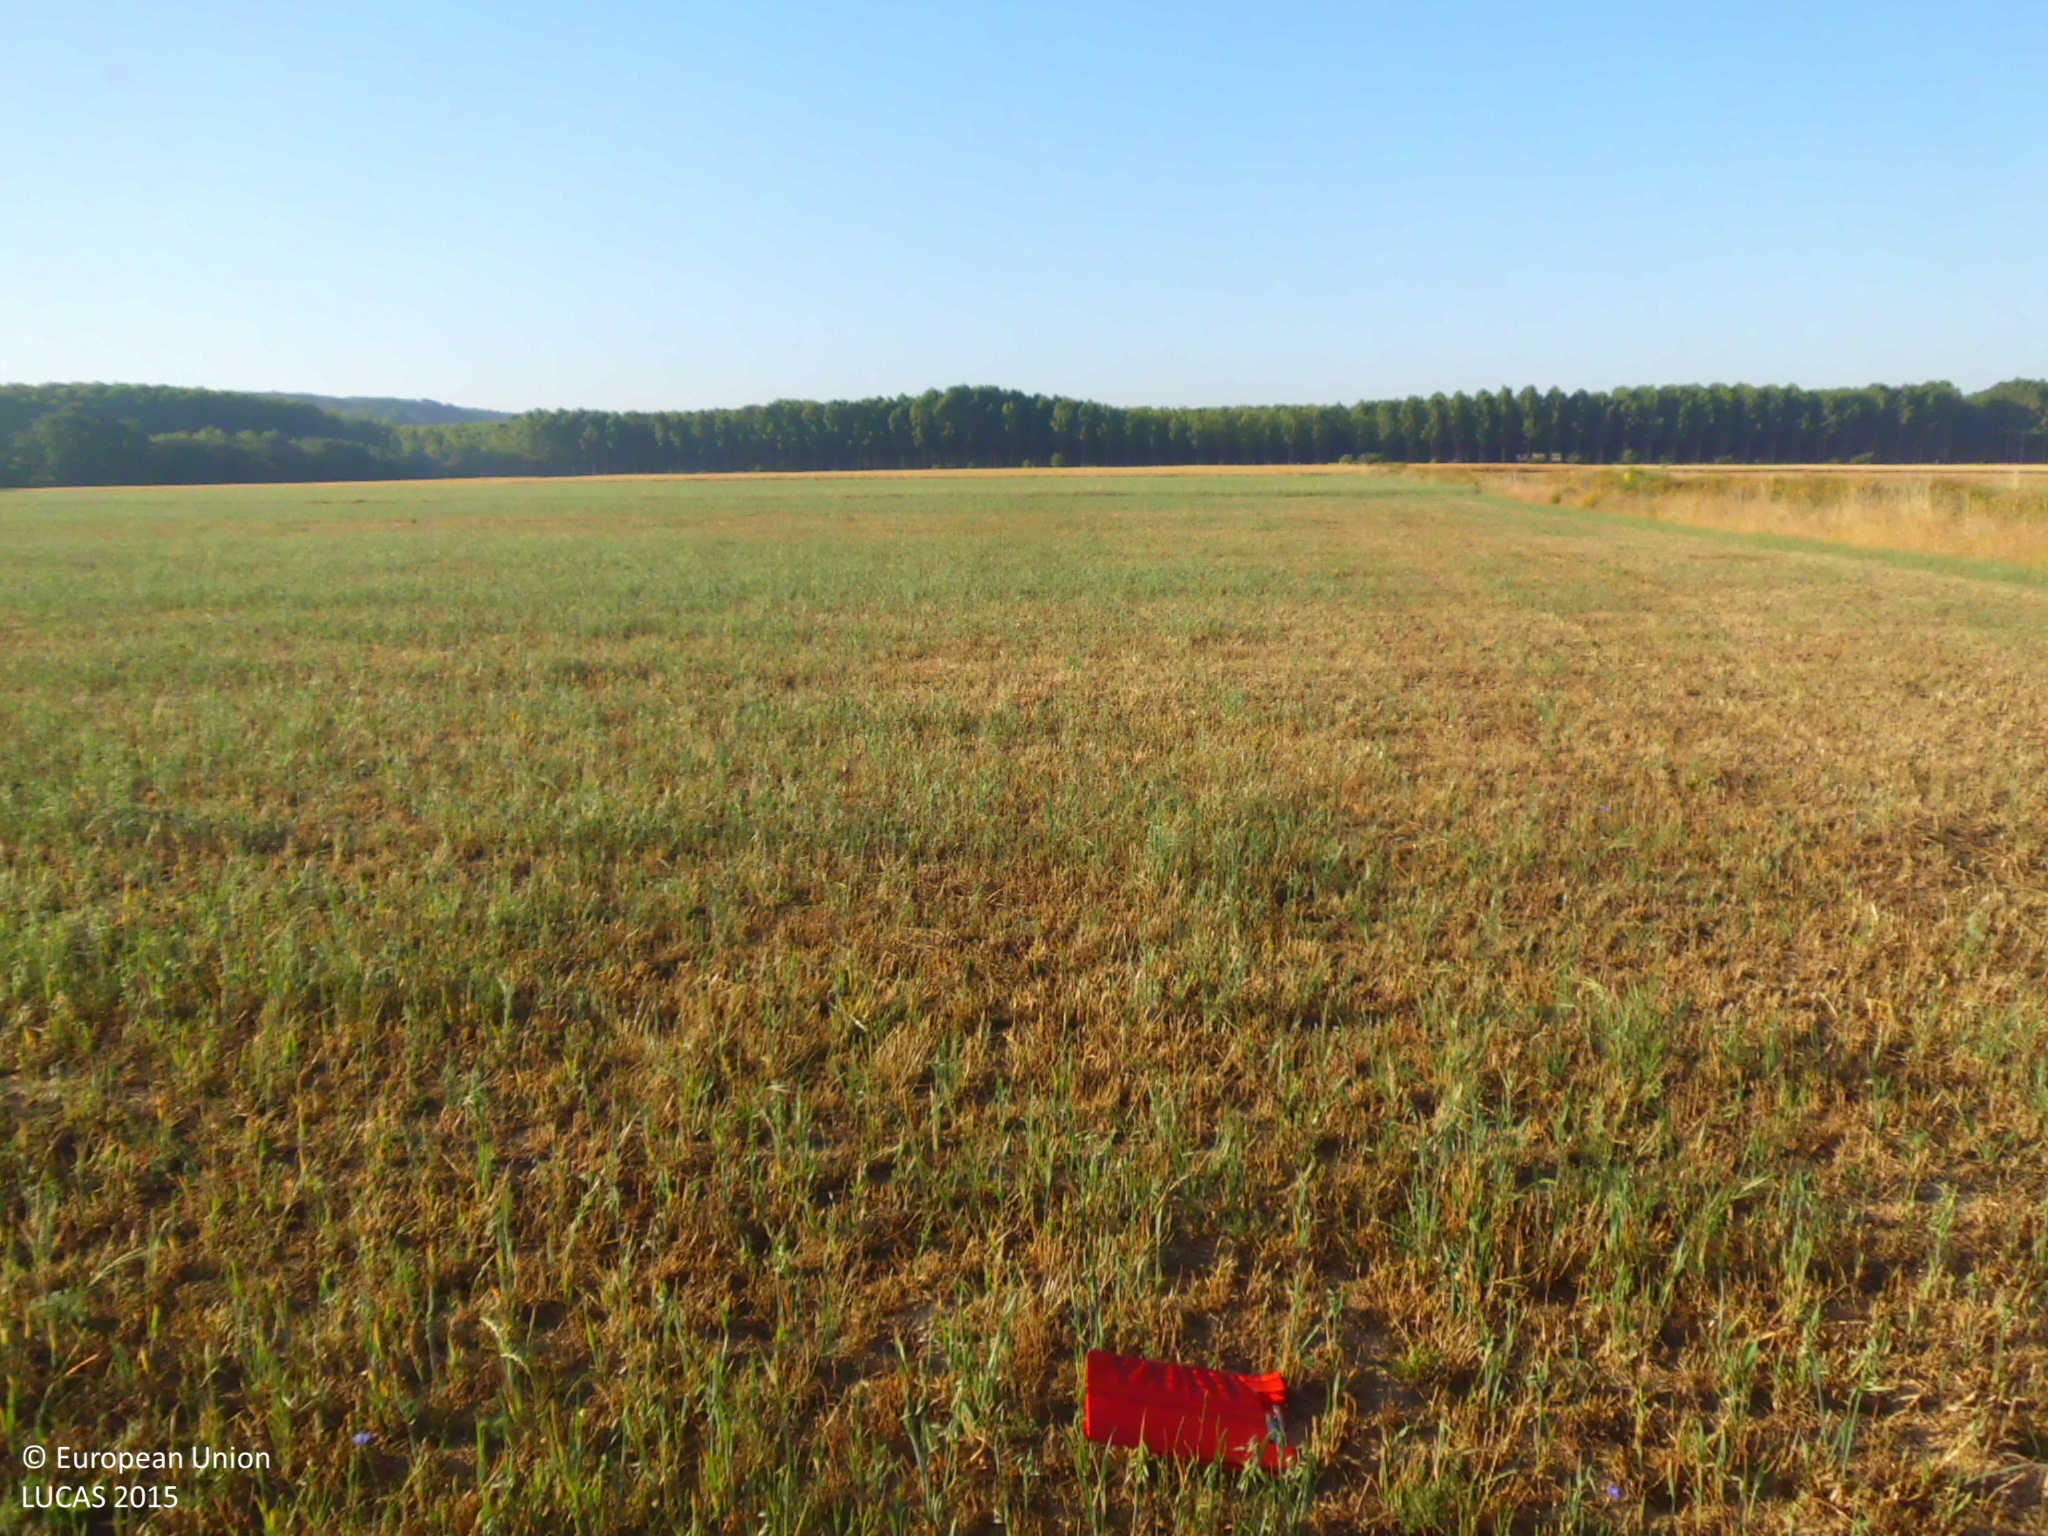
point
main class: Grassland
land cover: Spontaneously vegetated surfaces
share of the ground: 50 - 75 %
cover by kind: herbaceous plants 60 %, unconsolidated bare surface 40 %
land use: Fallow land
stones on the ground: < 10 %
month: June
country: ES
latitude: 42.6440
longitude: -5.0276
